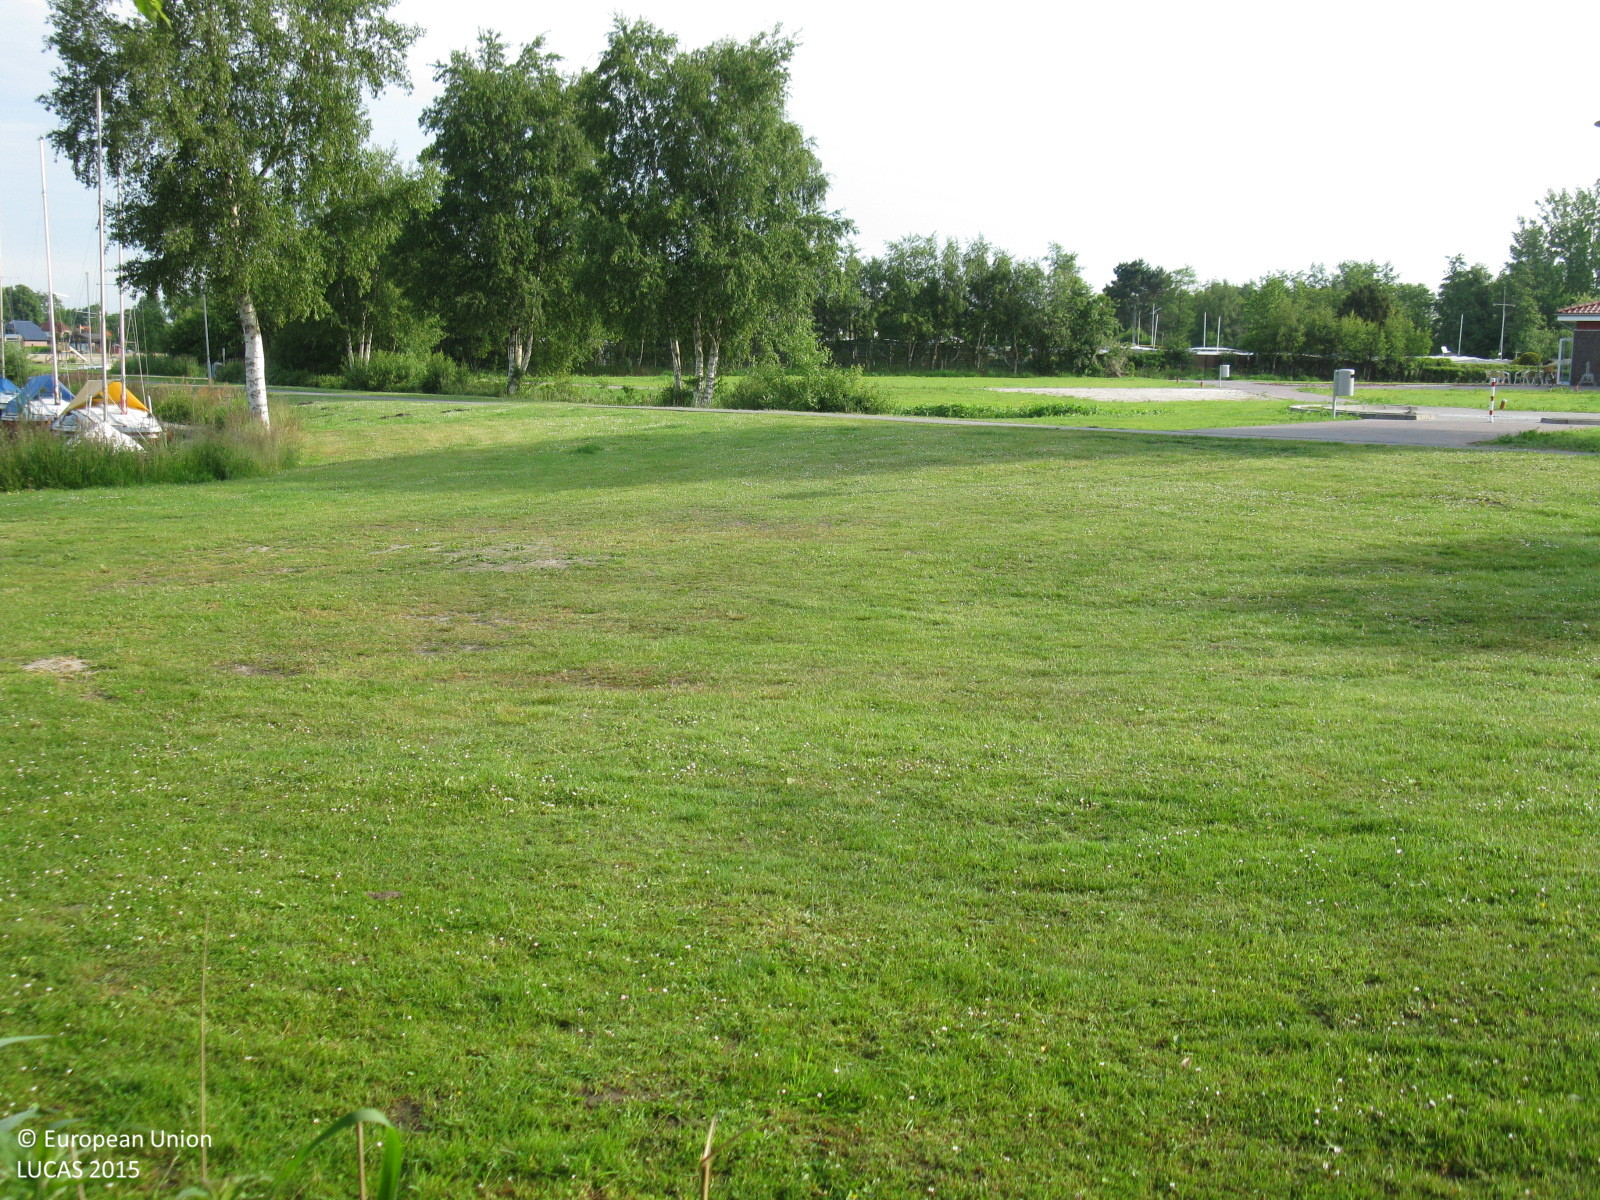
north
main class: Woodland
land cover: Broadleaved woodland
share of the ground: > 75 %
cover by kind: broadleaved forest trees 100 %
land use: Commerce
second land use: Amenities, museums, leisure
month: June
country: DE
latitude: 53.4439
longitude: 7.3057
